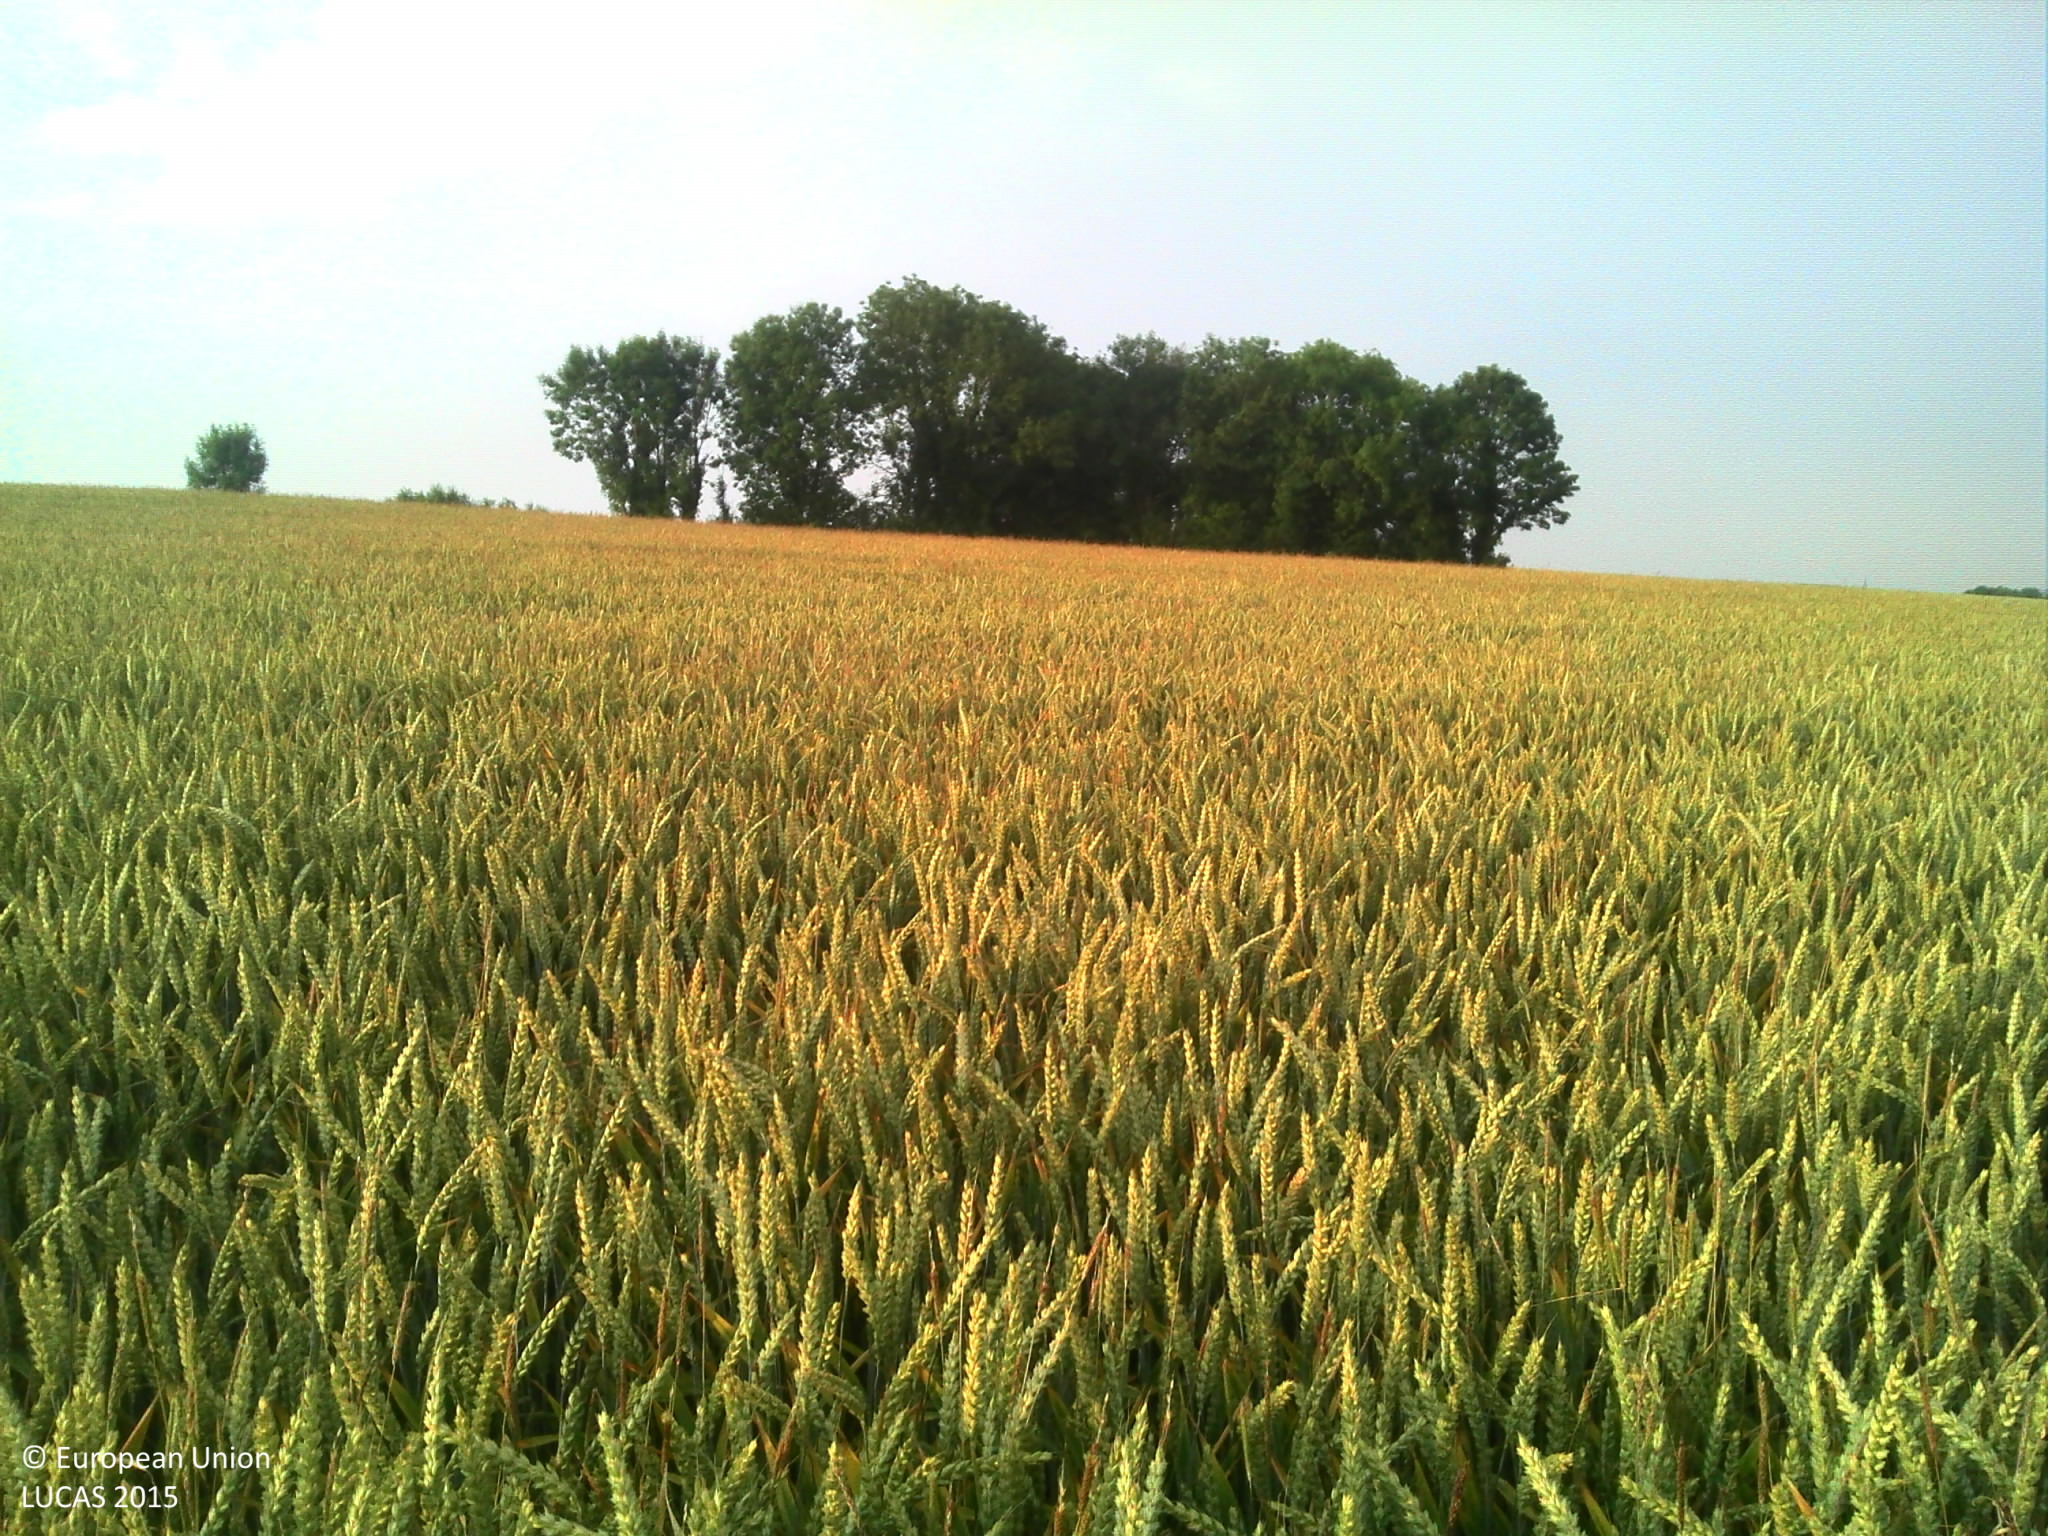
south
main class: Cropland
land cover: Common wheat
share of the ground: > 75 %
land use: Agriculture (excluding fallow land and kitchen gardens)
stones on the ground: 10 - 25 %
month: July
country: FR
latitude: 49.7852
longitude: 2.3898
